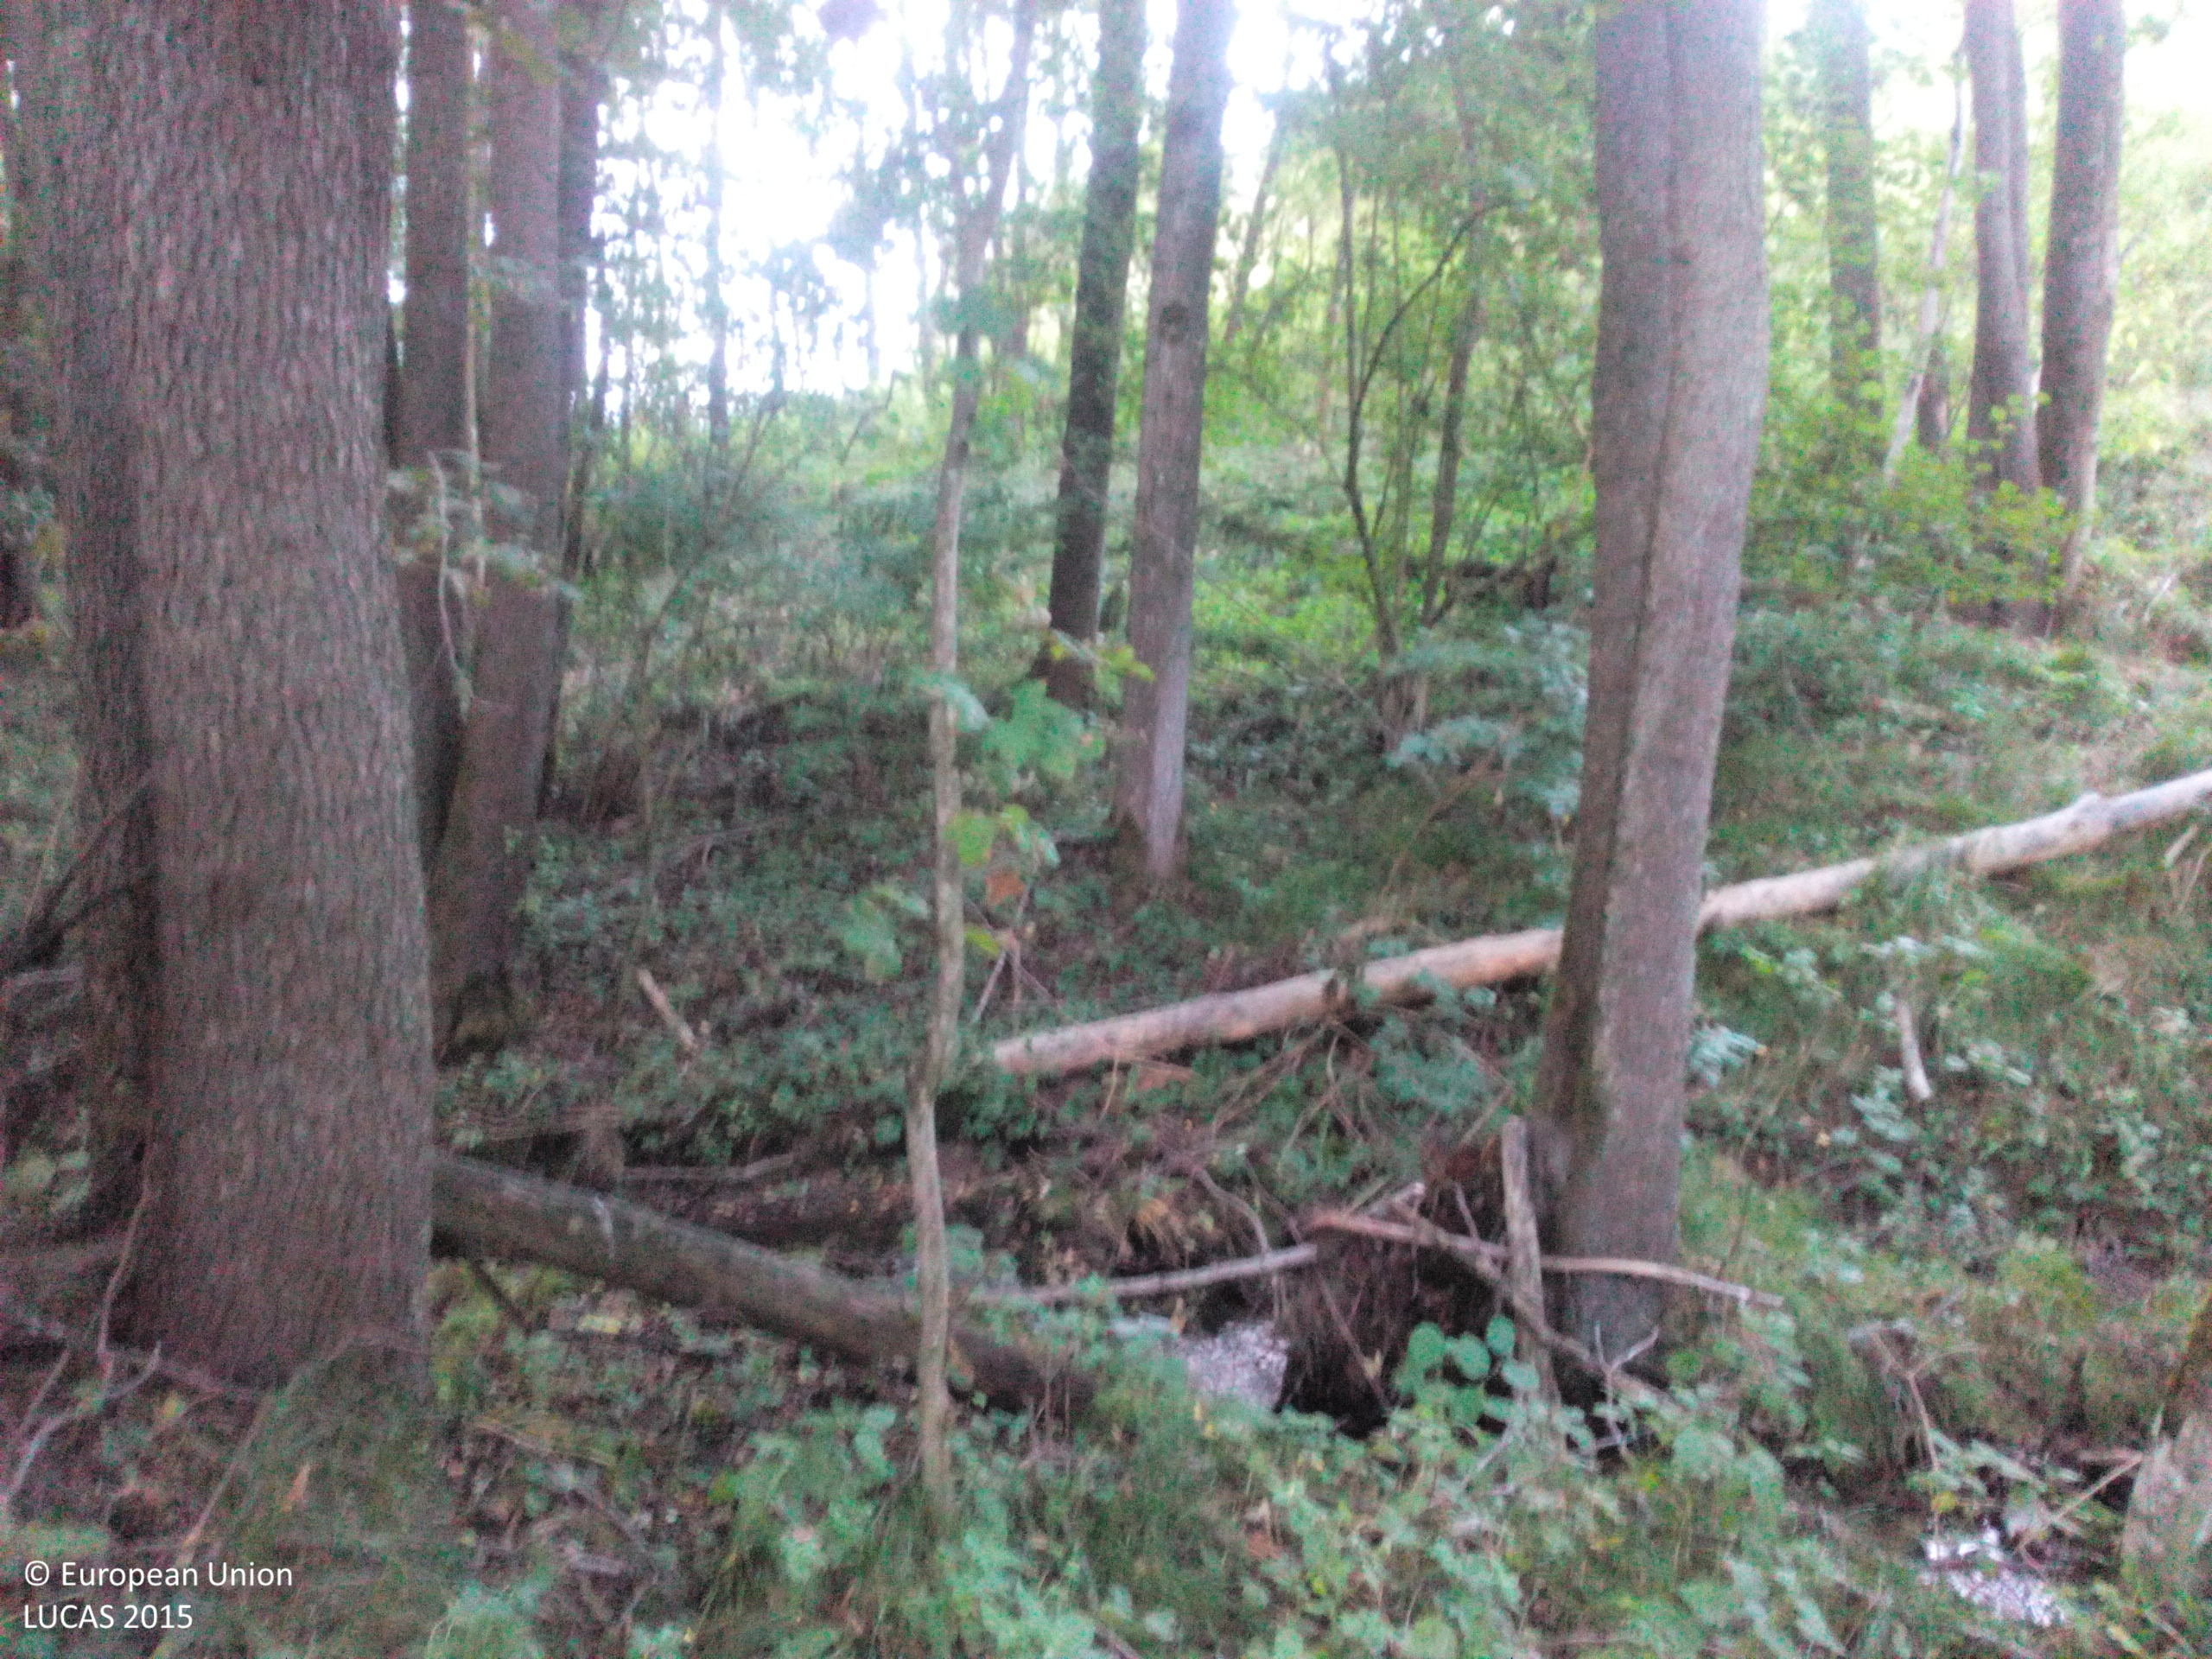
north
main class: Woodland
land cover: Broadleaved woodland
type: mesophytic deciduous forest
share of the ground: > 75 %
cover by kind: broadleaved forest trees 100 %
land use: Semi-natural and natural areas not in use
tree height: > 5 m
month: September
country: DE
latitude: 48.9939
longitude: 12.9653
